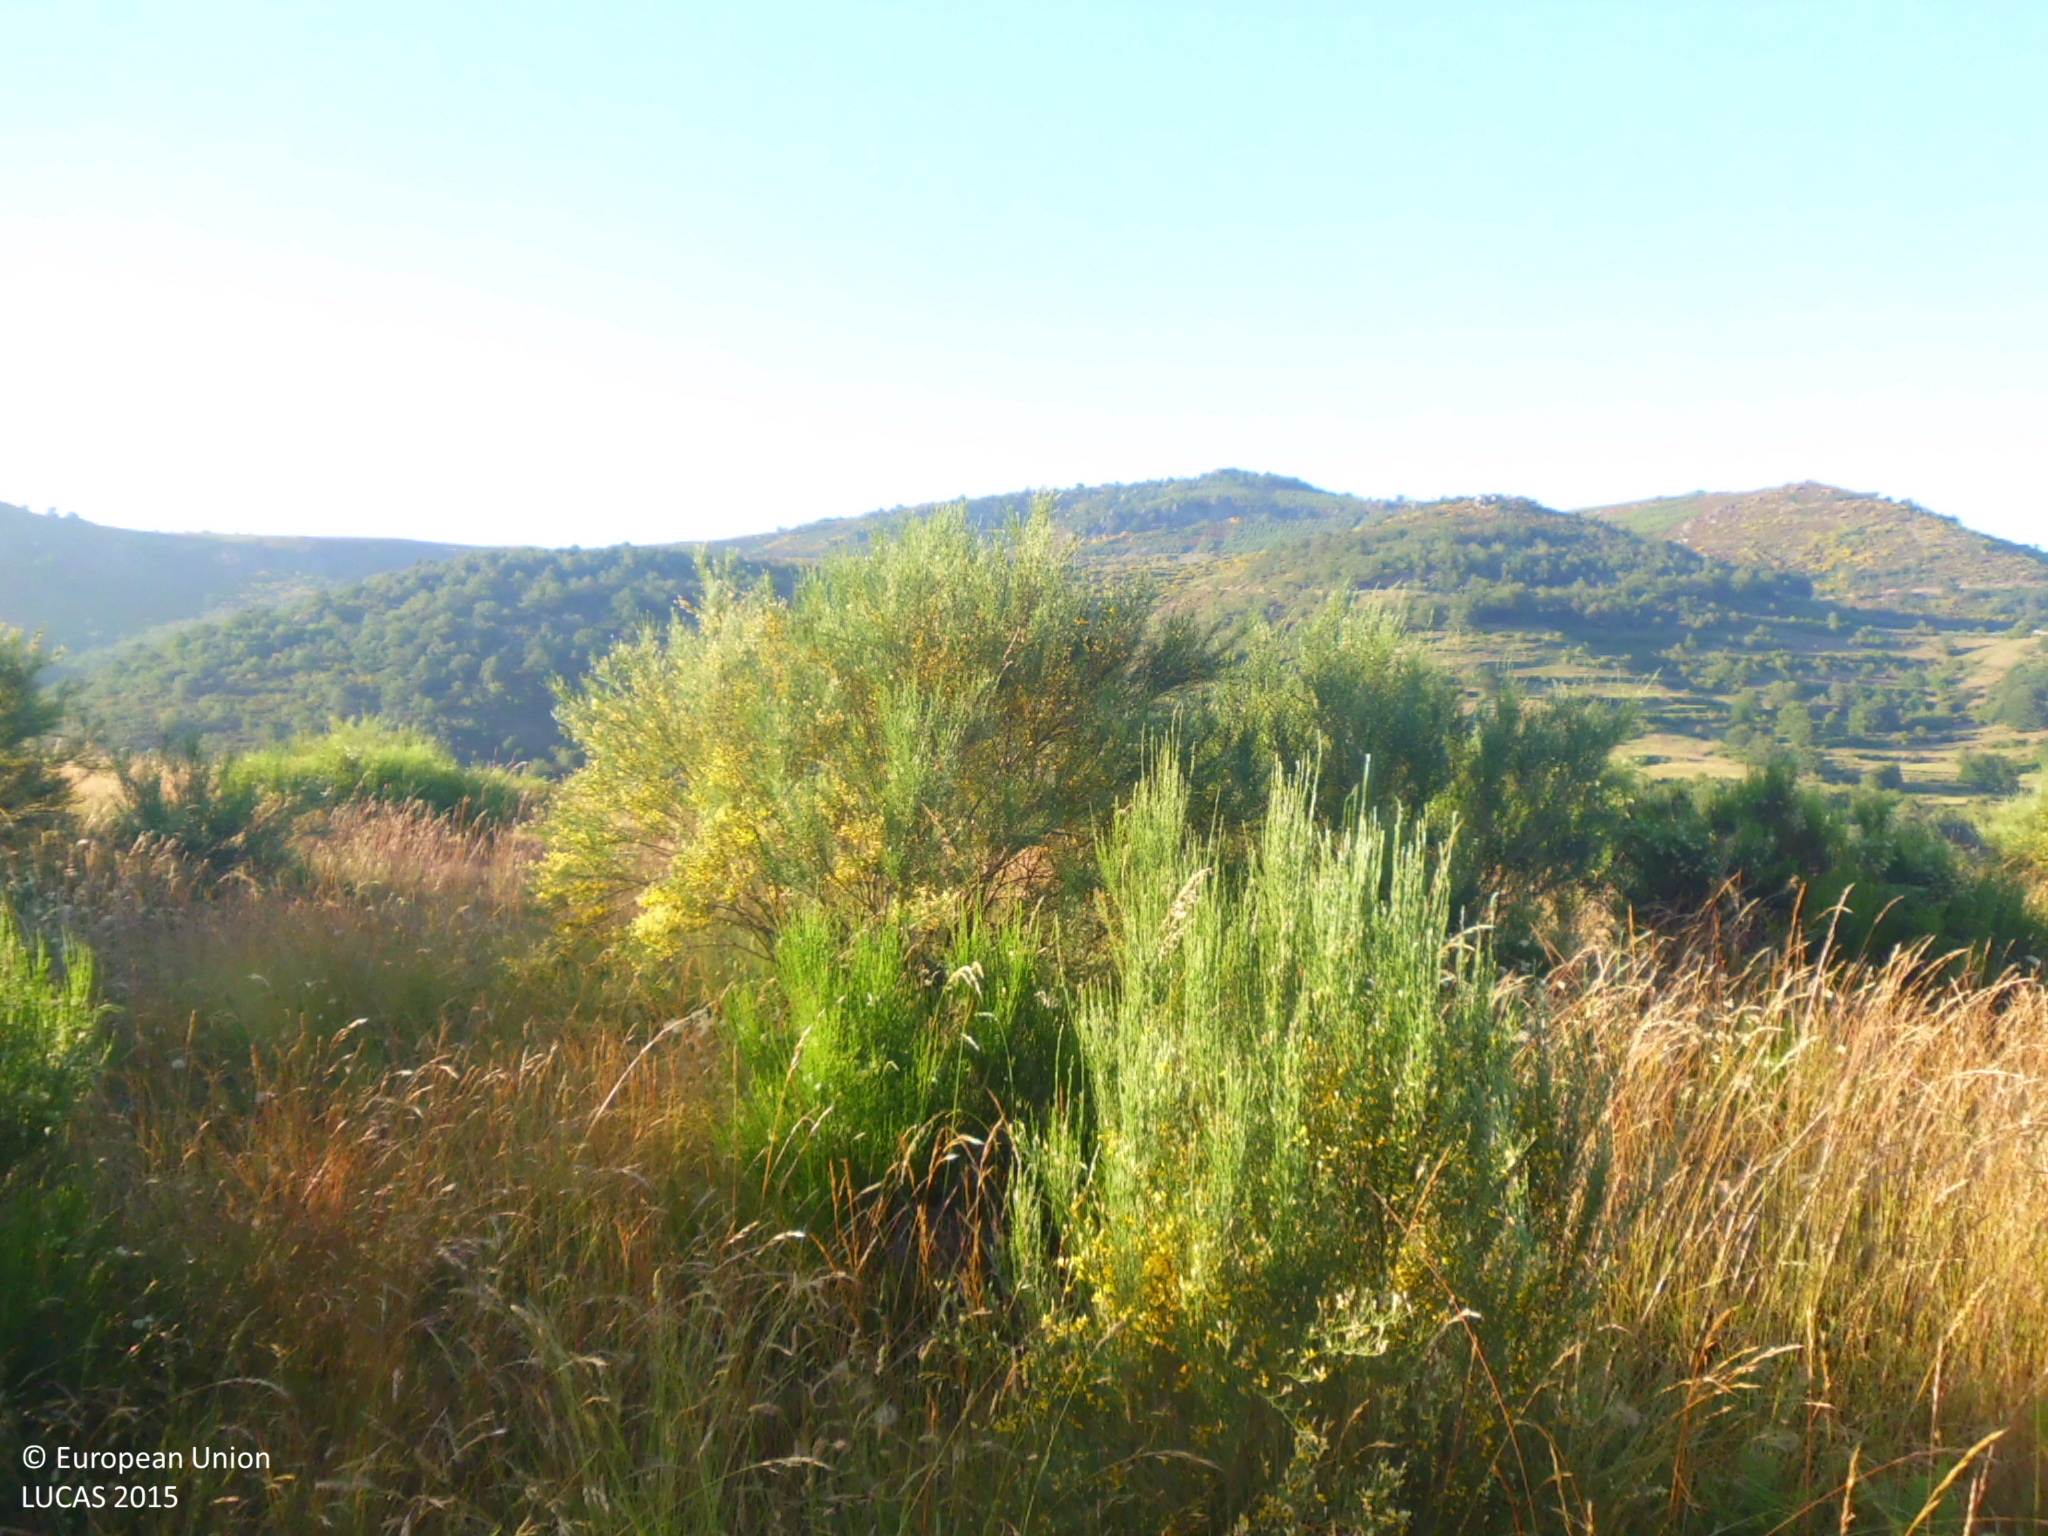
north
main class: Shrubland
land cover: Shrubland without tree cover
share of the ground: 25 - 50 %
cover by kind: shrubs 35 %, herbaceous plants 35 %, consolidated bare surface 30 %
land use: Agriculture (excluding fallow land and kitchen gardens)
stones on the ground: 10 - 25 %
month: June
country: ES
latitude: 42.9090
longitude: -4.9709
